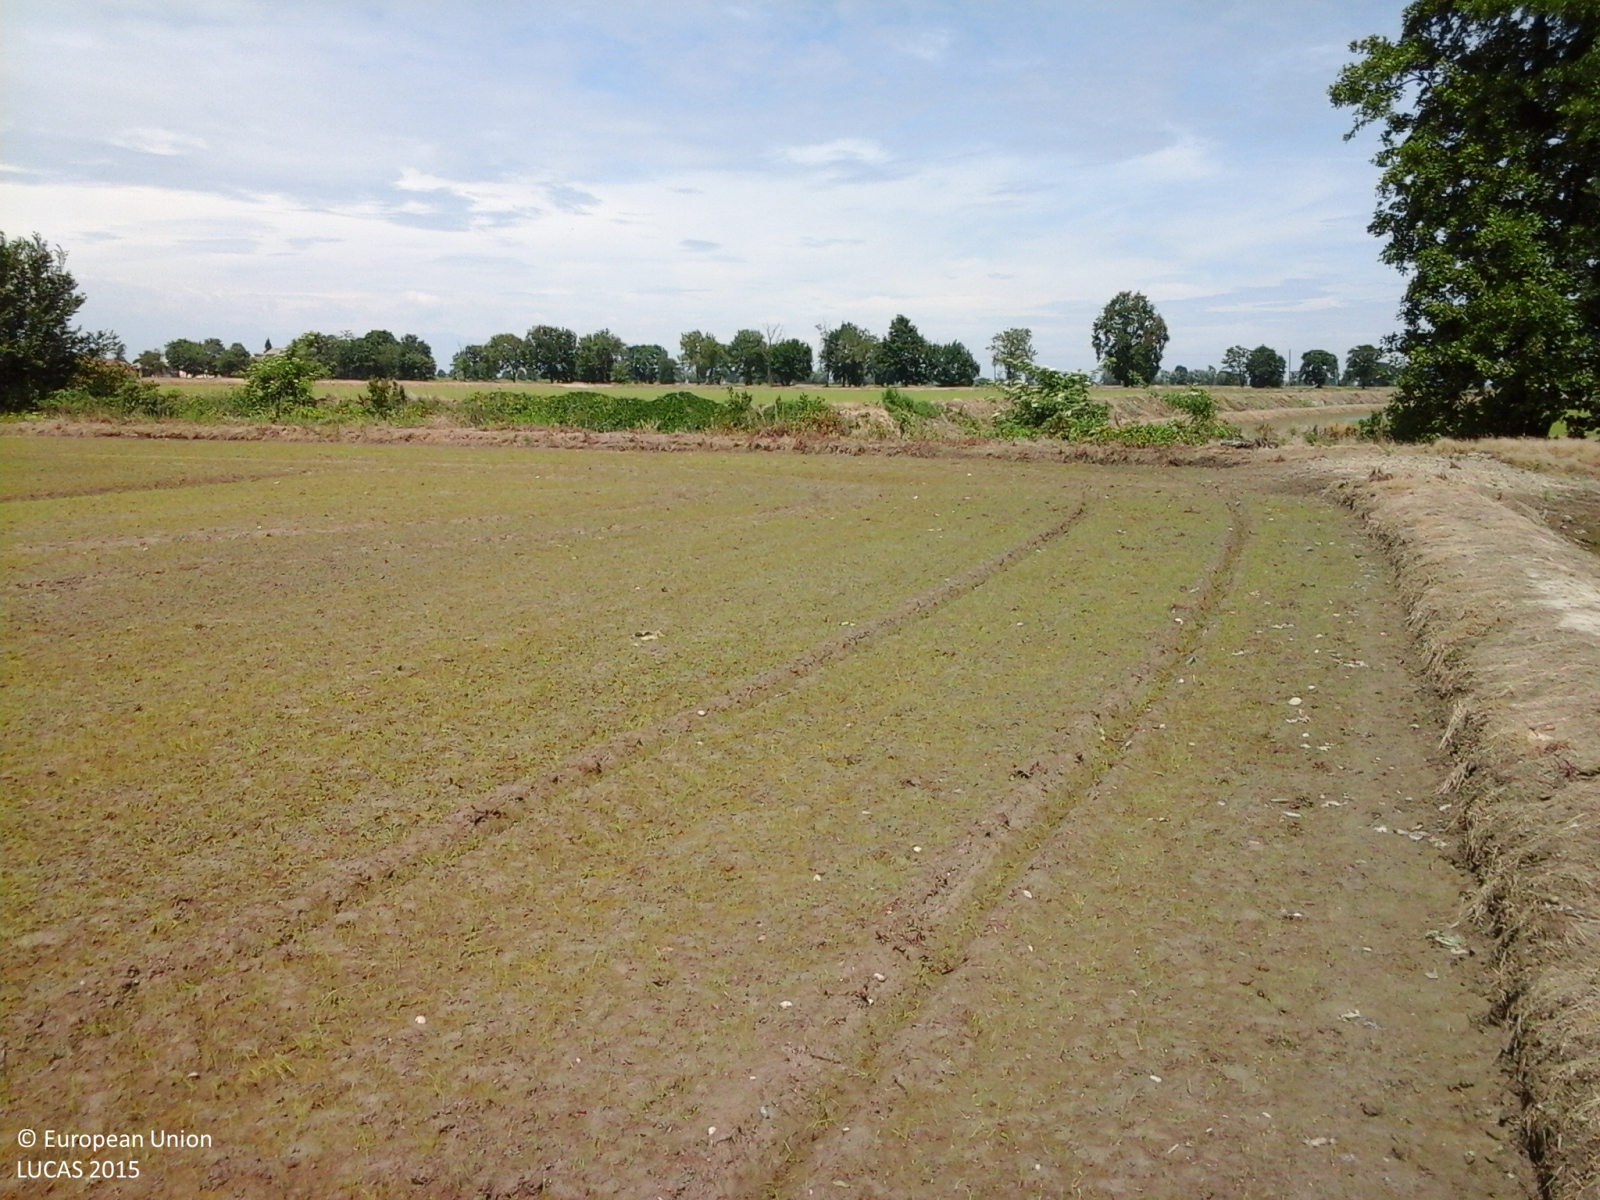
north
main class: Cropland
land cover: Rice
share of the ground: < 10 %
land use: Agriculture (excluding fallow land and kitchen gardens)
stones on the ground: < 10 %
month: May
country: IT
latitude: 45.2548
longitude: 8.2064
